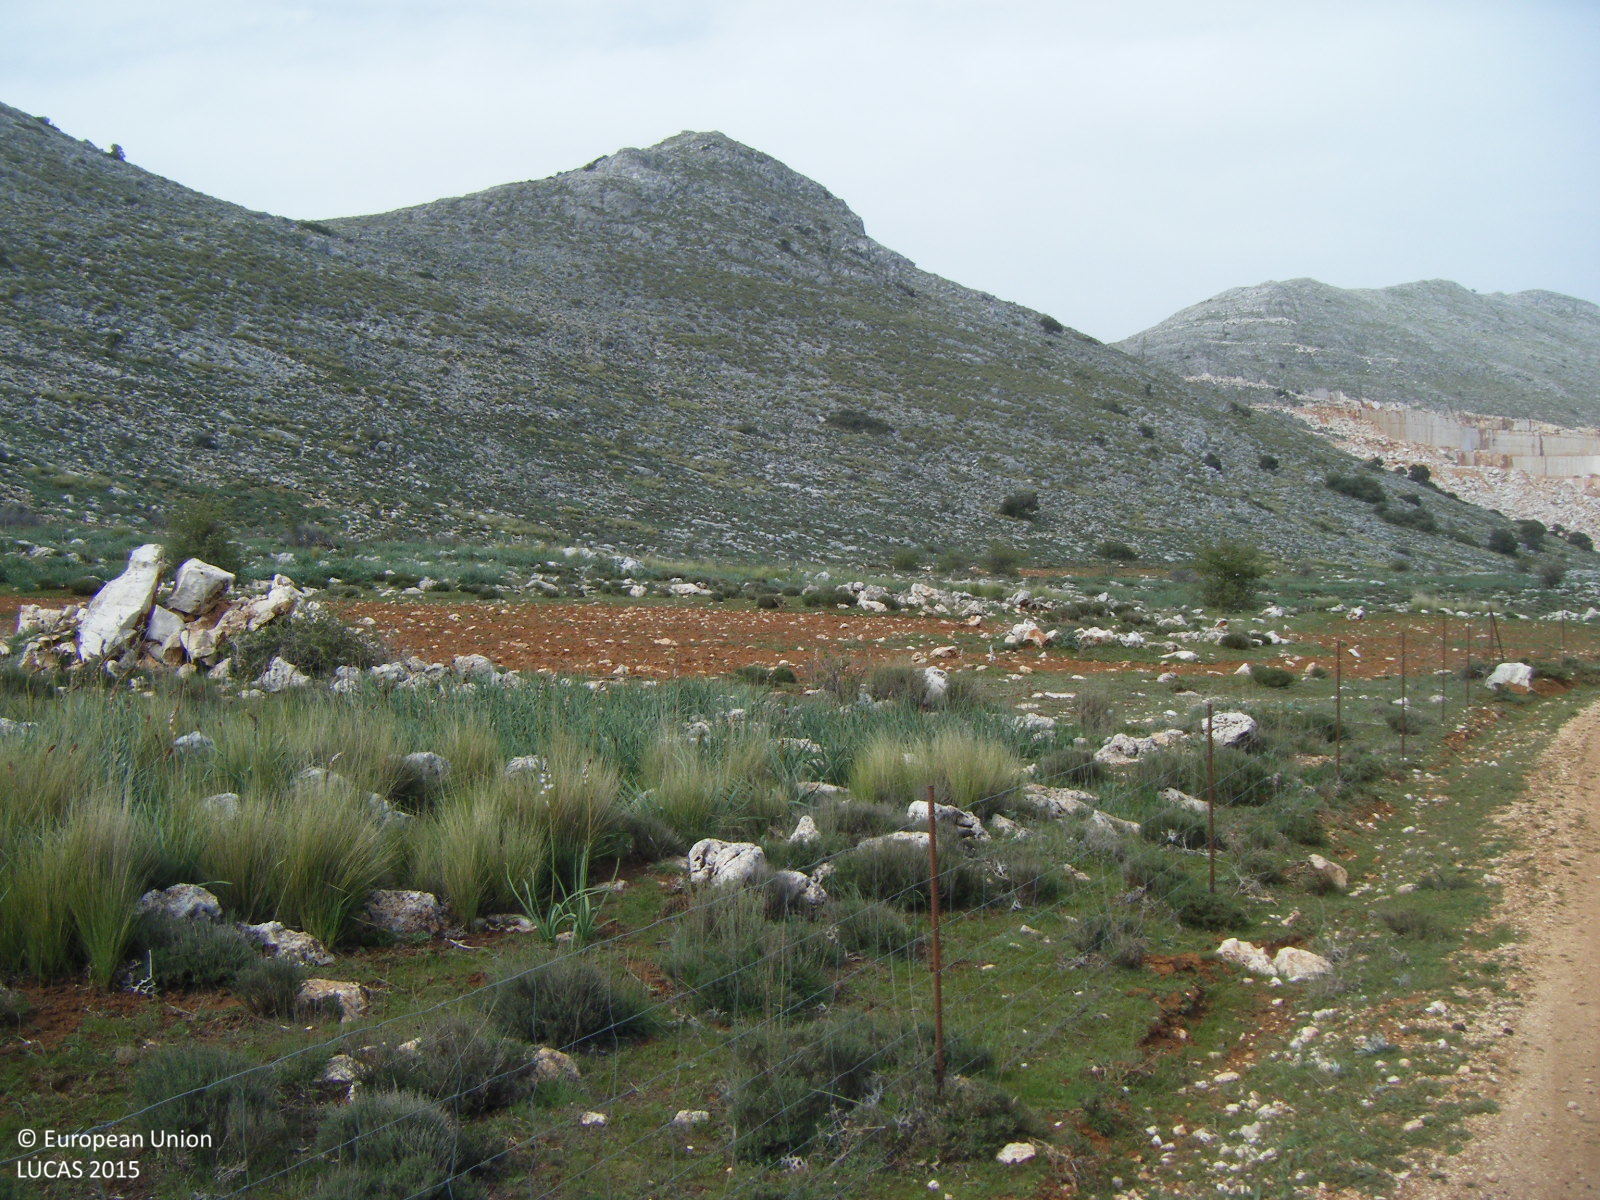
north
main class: Grassland
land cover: Grassland without tree/shrub cover
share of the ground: 50 - 75 %
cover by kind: herbaceous plants 50 %, consolidated bare surface 50 %
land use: Agriculture (excluding fallow land and kitchen gardens)
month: April
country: ES
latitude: 37.0903
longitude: -4.1348
